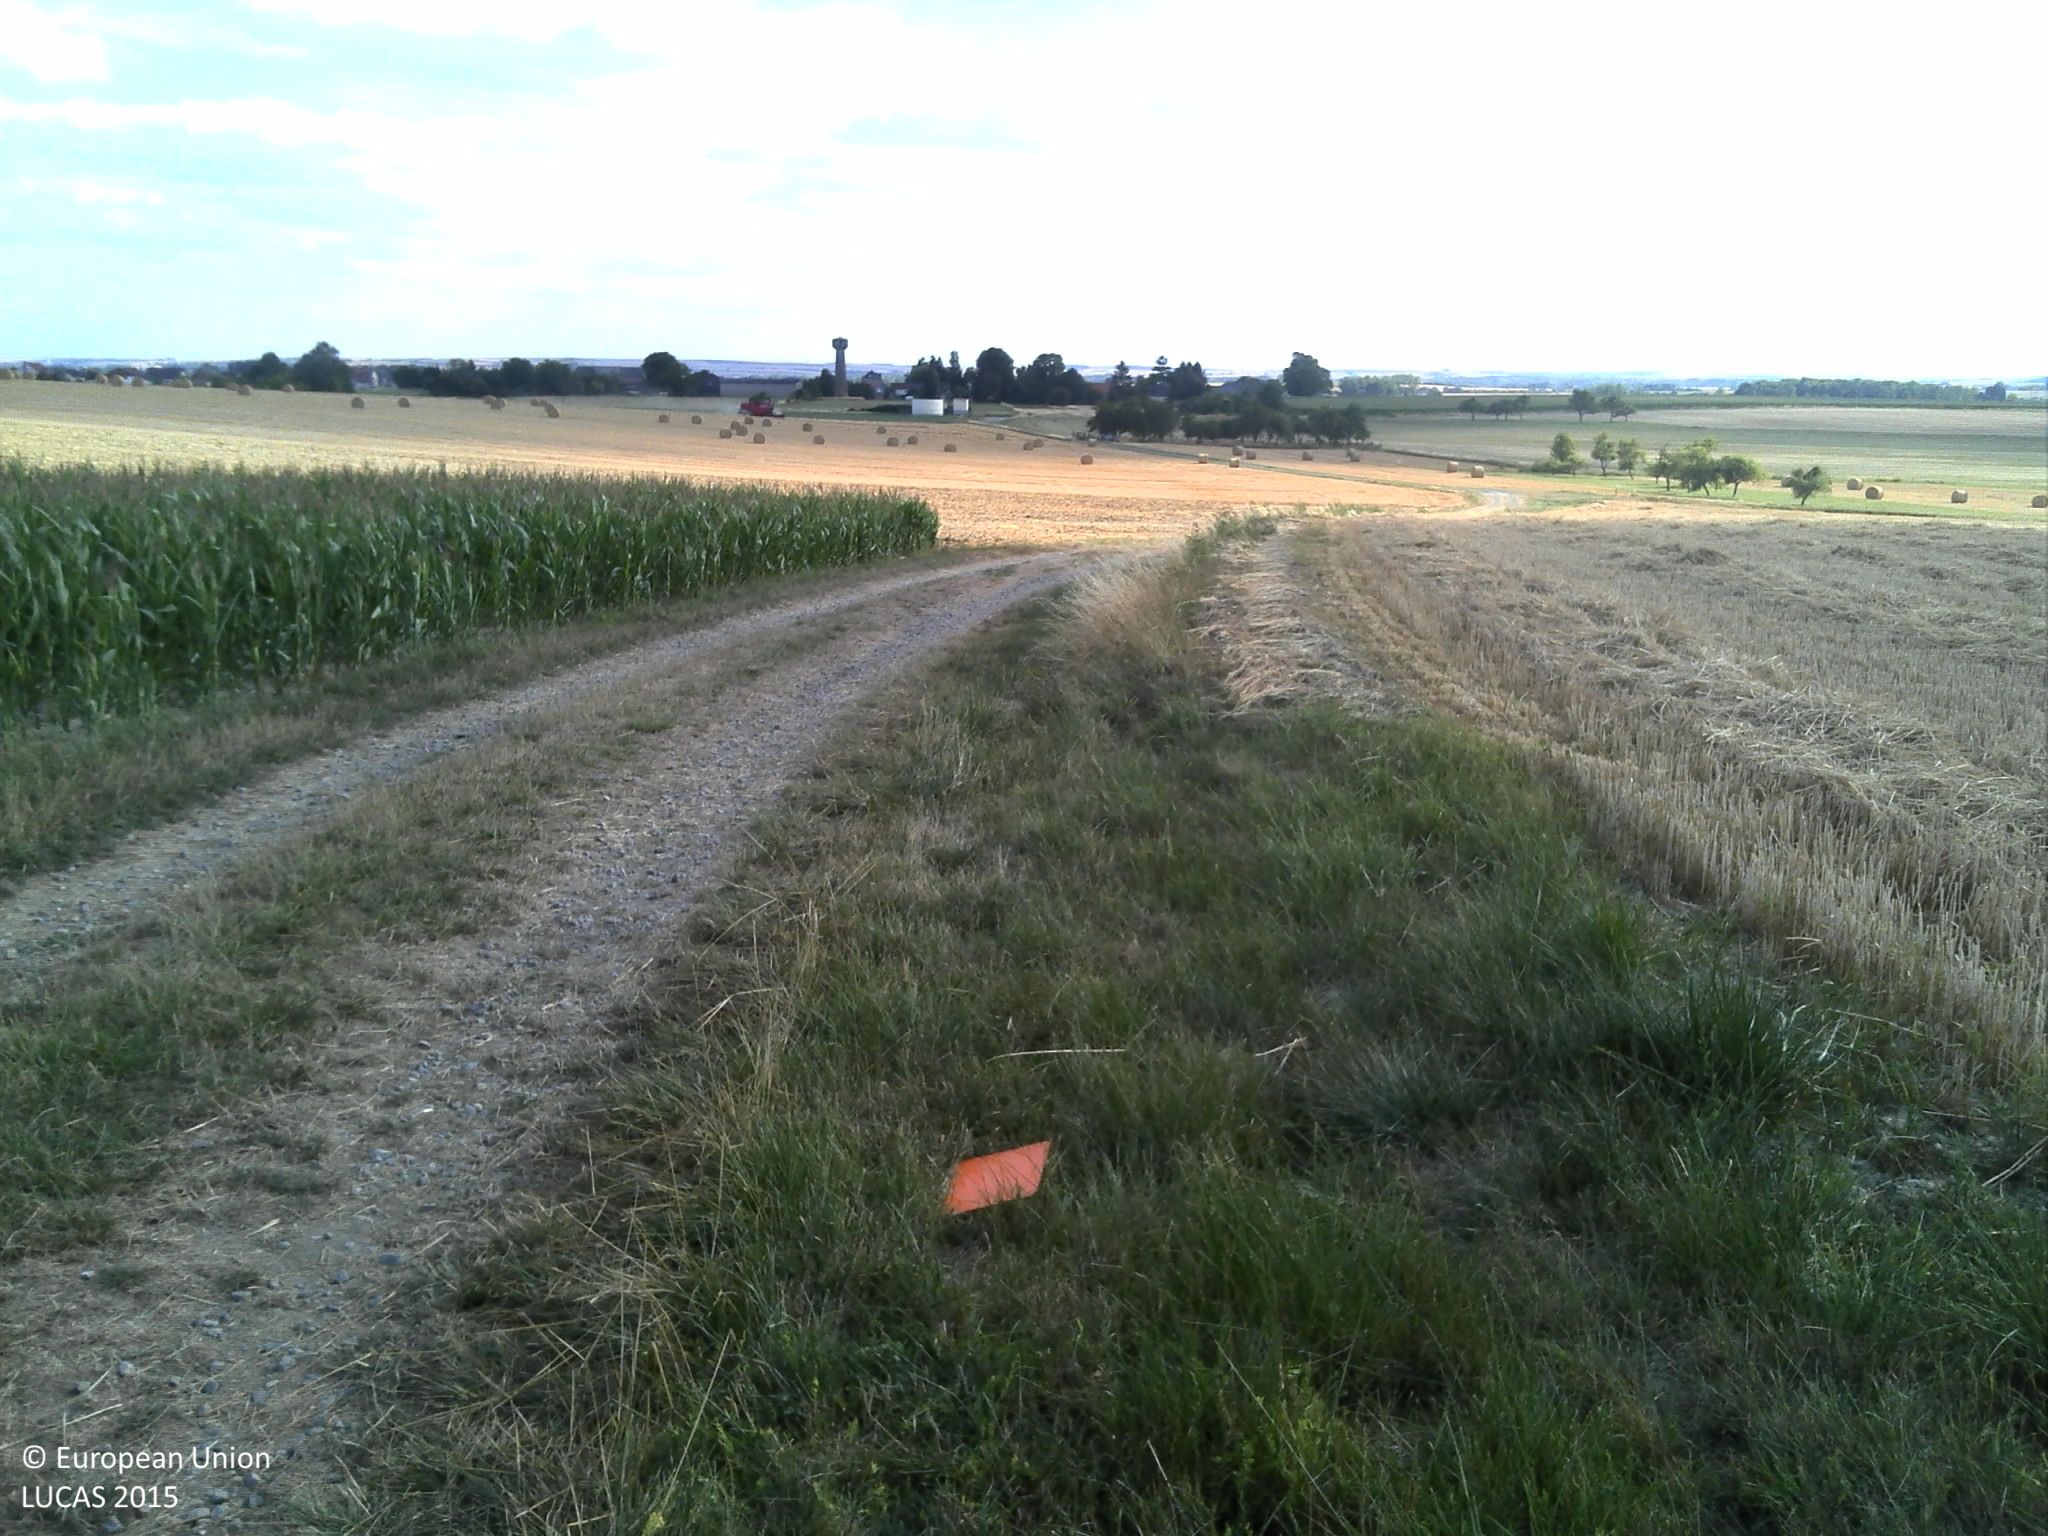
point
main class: Cropland
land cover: Common wheat
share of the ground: > 75 %
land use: Agriculture (excluding fallow land and kitchen gardens)
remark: Harvested field
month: July
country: FR
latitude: 49.5459
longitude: 4.4816
